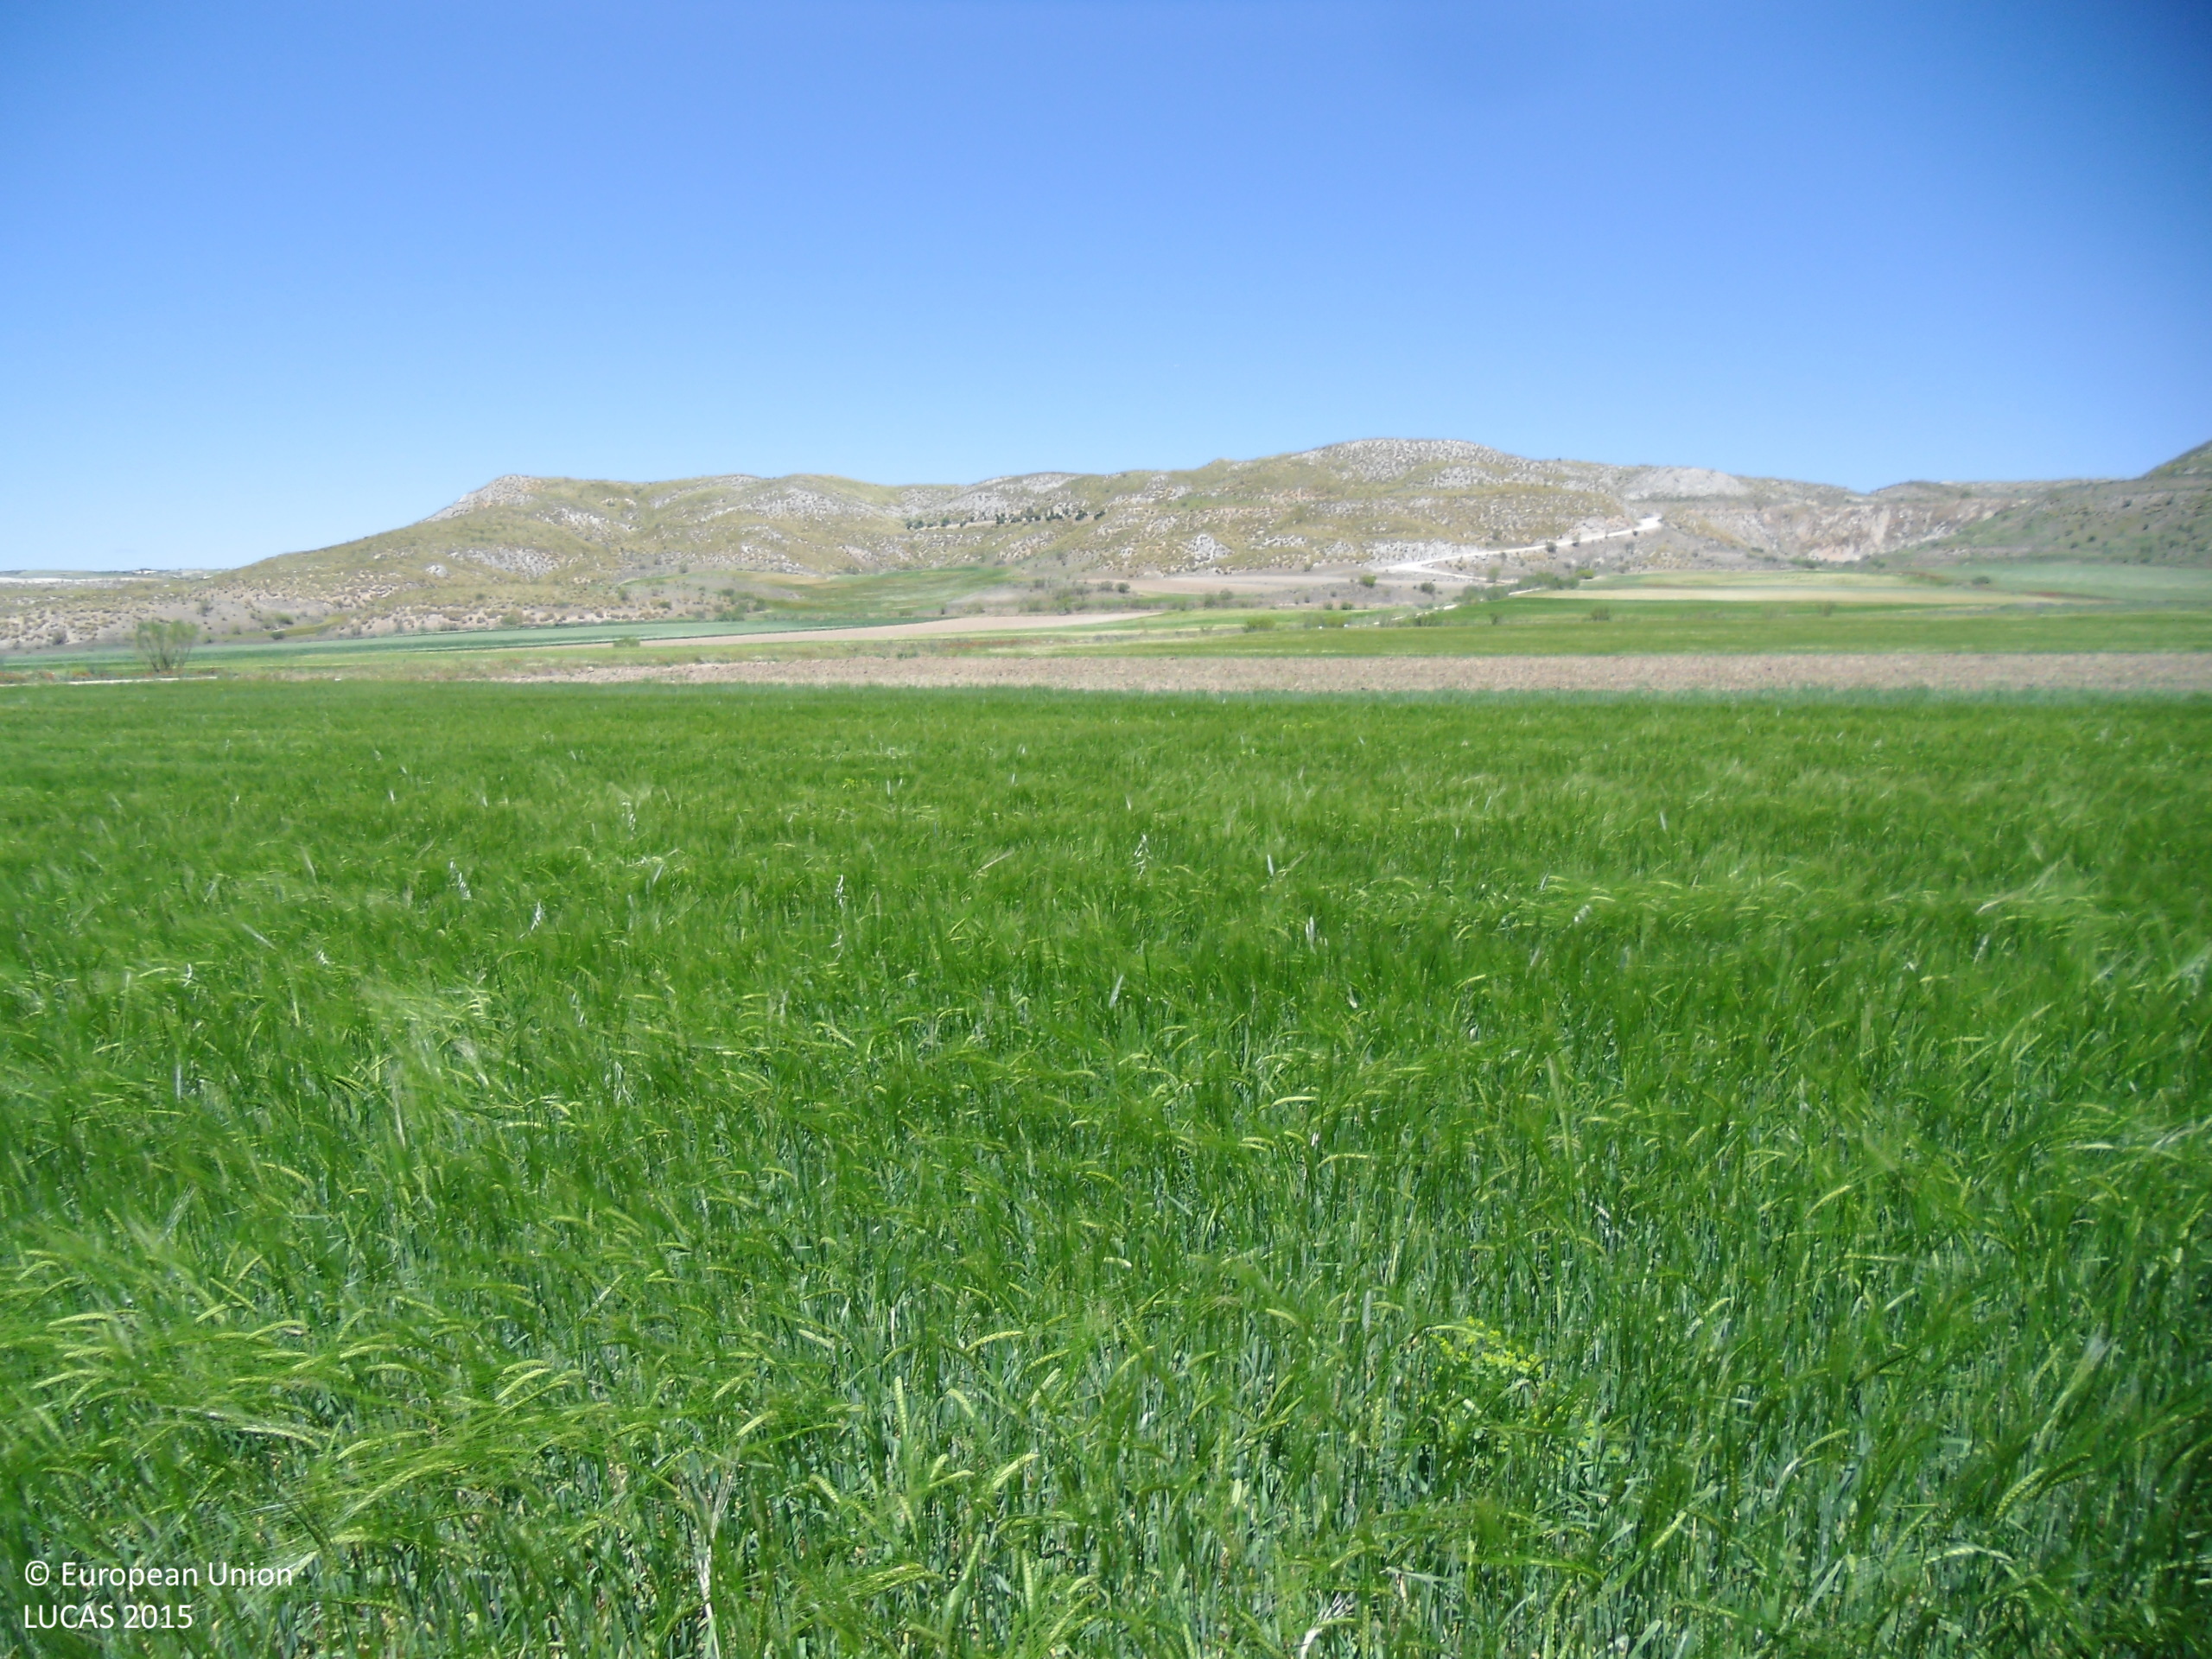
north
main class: Cropland
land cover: Barley
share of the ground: > 75 %
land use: Agriculture (excluding fallow land and kitchen gardens)
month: May
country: ES
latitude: 40.1761
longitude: -2.9311
